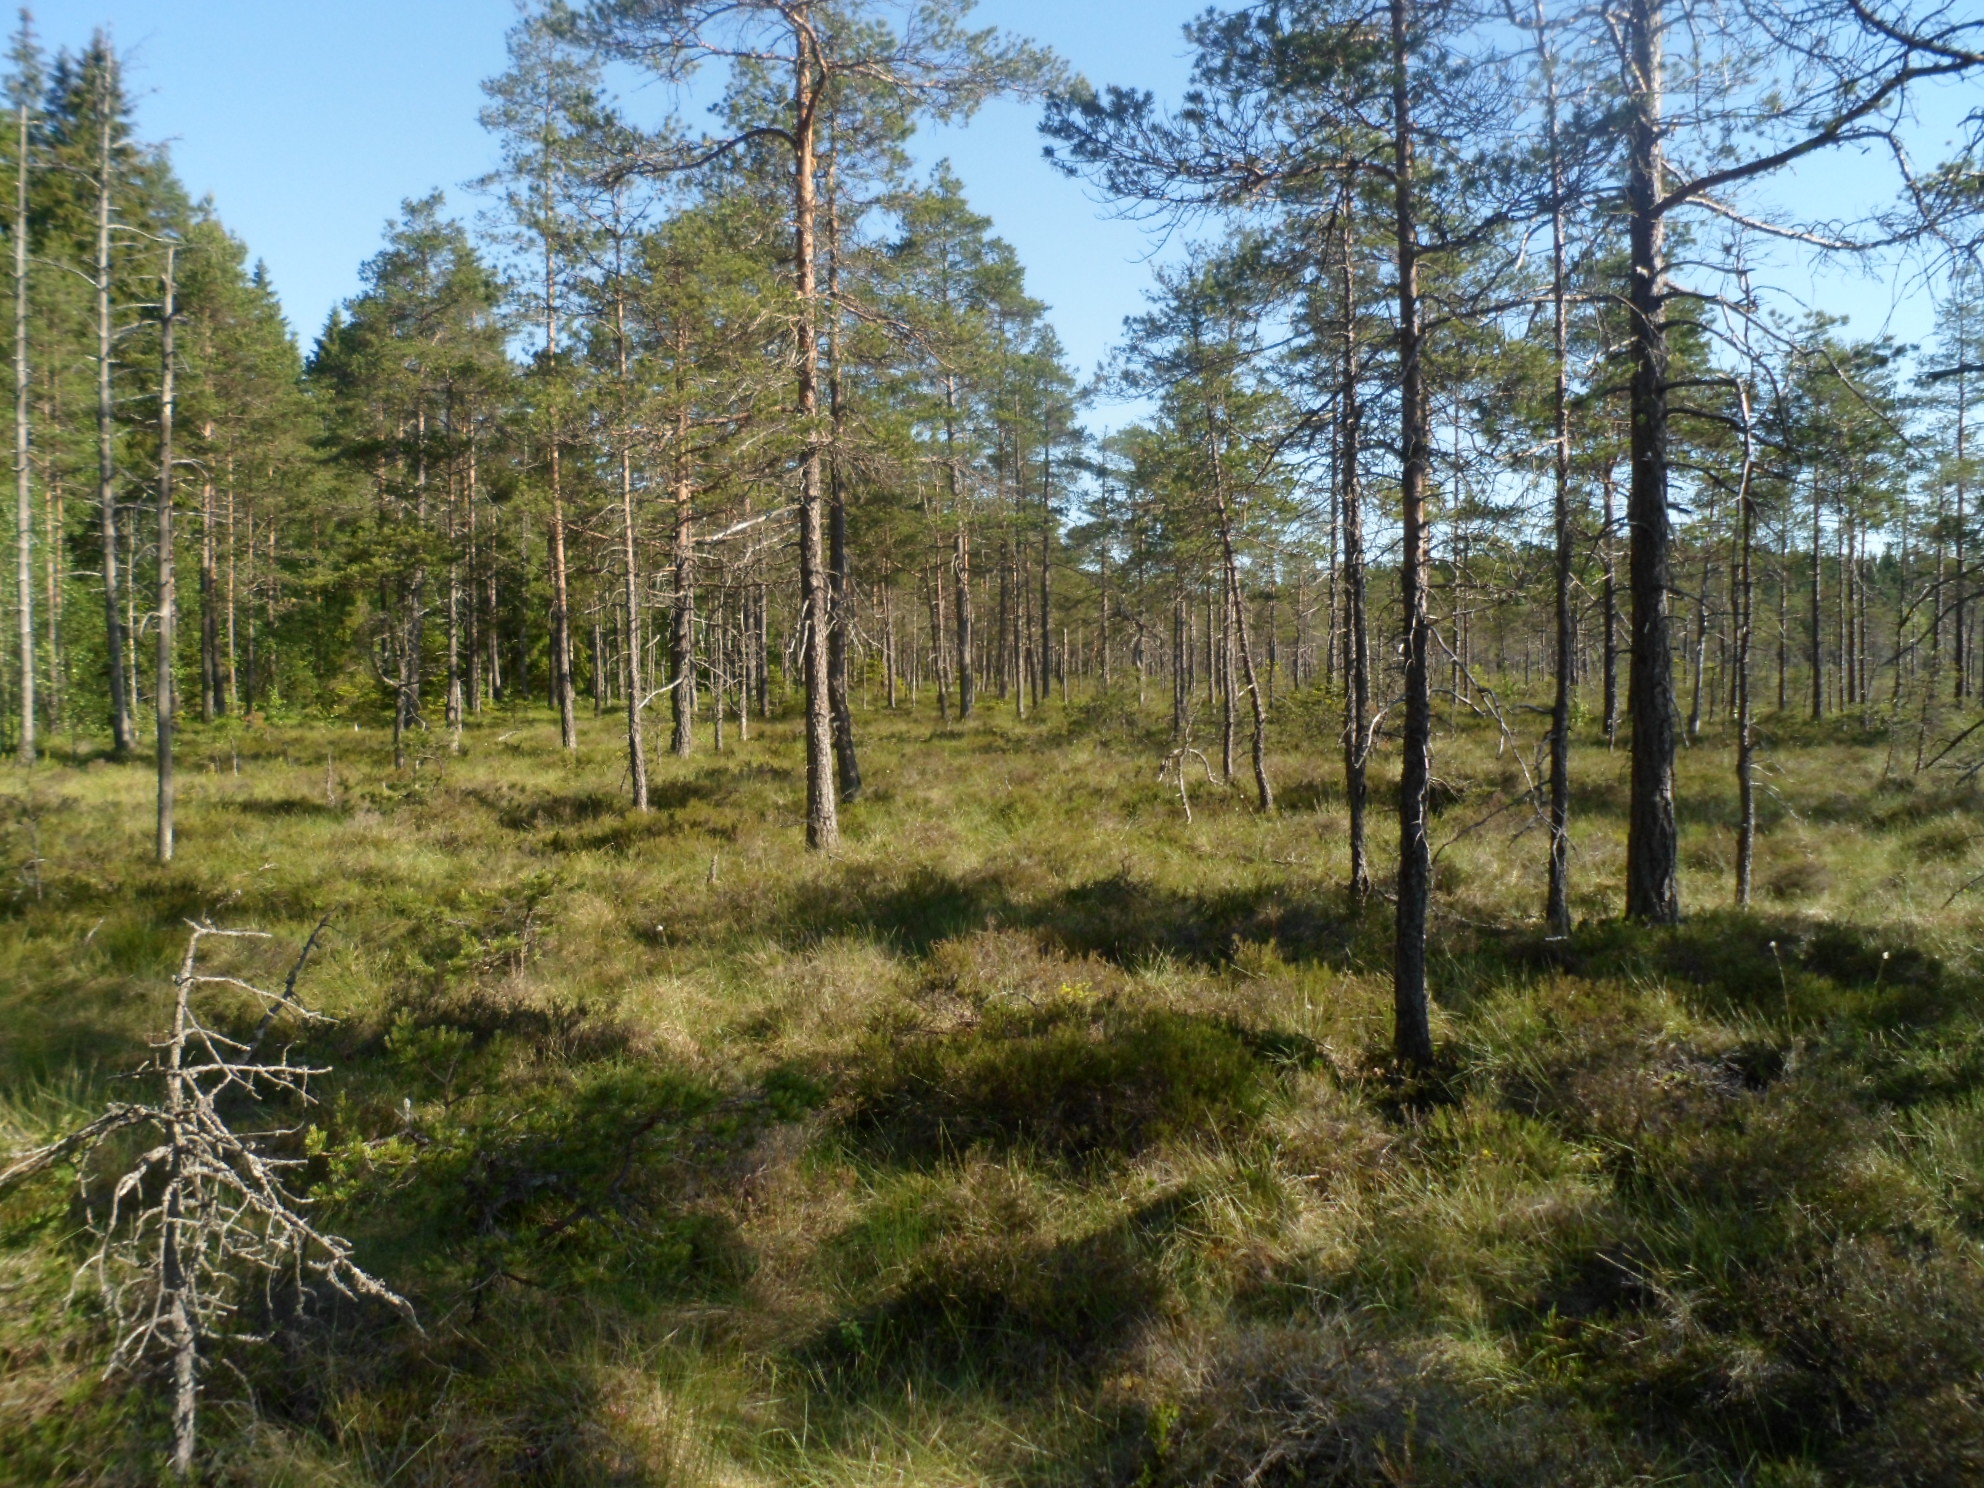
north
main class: Woodland
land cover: Pine dominated coniferous woodland
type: boreal forest
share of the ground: 25 - 50 %
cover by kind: shrubs 35 %, coniferous forest trees 25 %, lichens and mosses 25 %, herbaceous plants 10 %, broadleaved forest trees 5 %
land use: Forestry
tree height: > 5 m
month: July
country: SE
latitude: 57.4962
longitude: 14.4840
